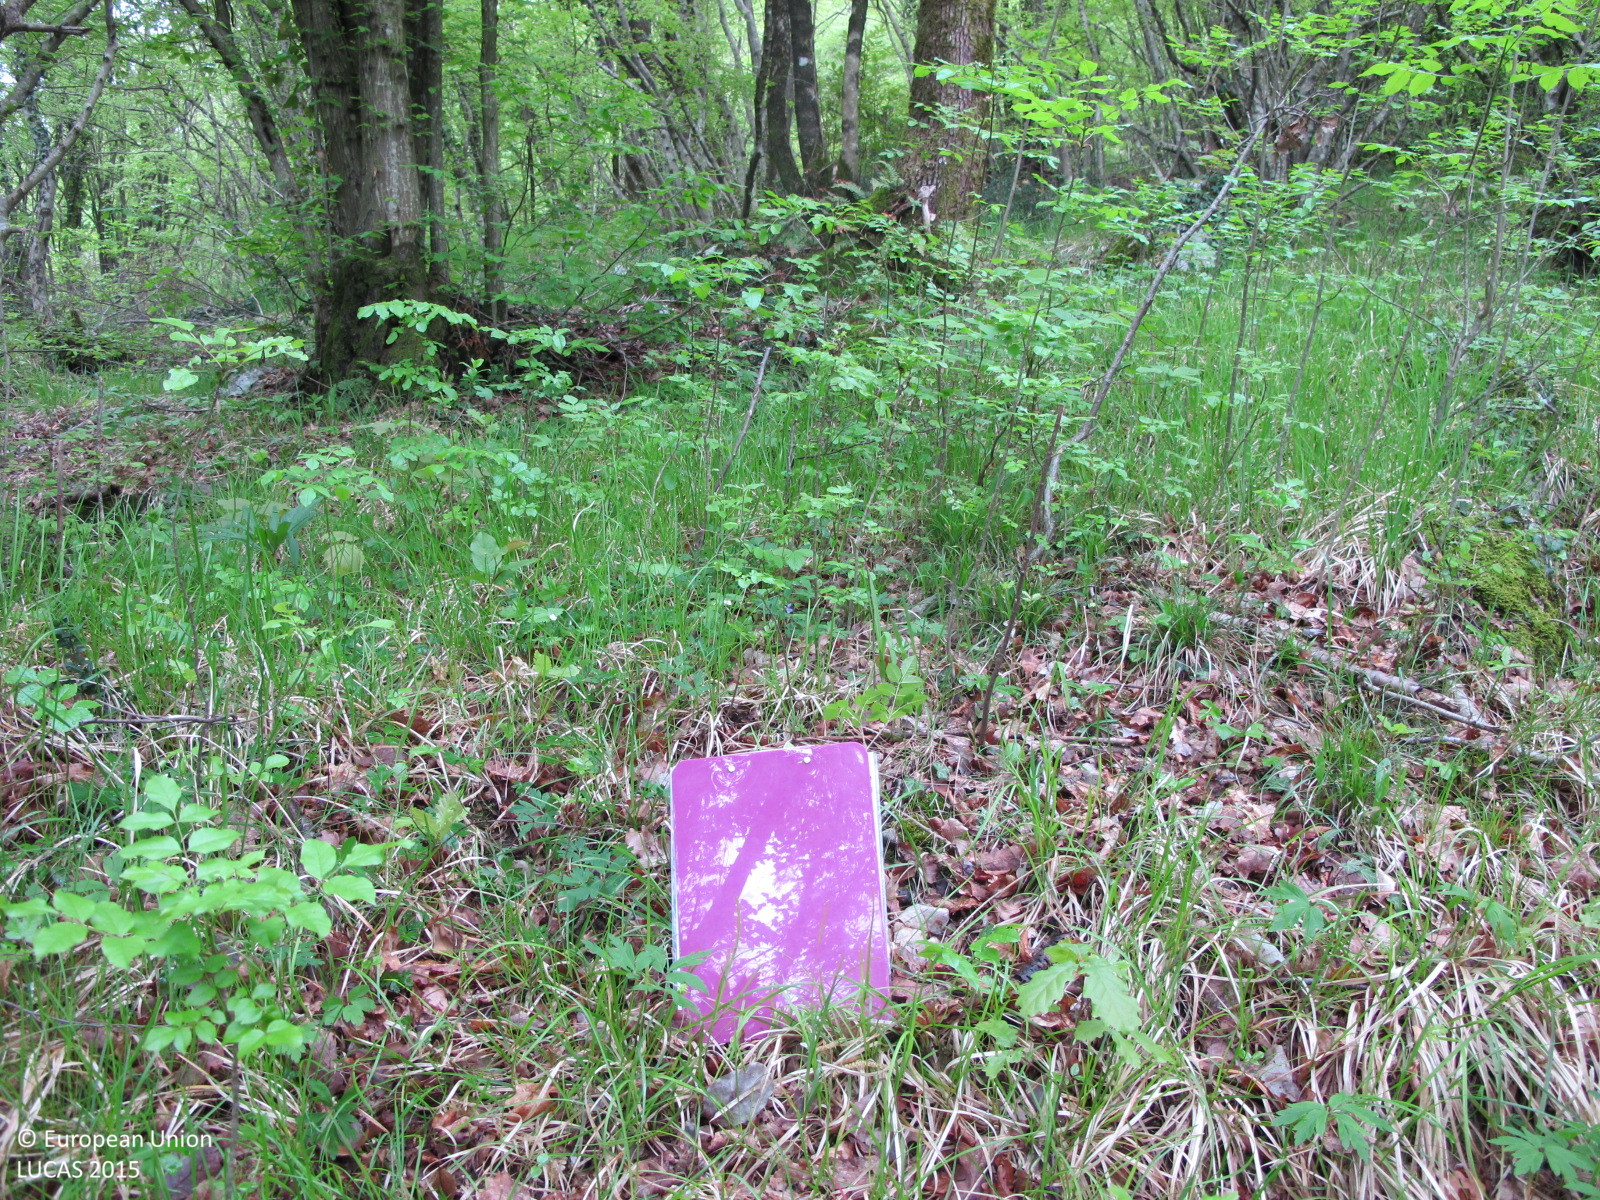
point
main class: Woodland
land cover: Broadleaved woodland
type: thermophilous deciduous forest
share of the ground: > 75 %
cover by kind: broadleaved forest trees 70 %, herbaceous plants 15 %, shrubs 5 %, lichens and mosses 5 %
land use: Semi-natural and natural areas not in use
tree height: > 5 m
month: April
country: HR
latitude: 45.3628
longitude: 14.2974
